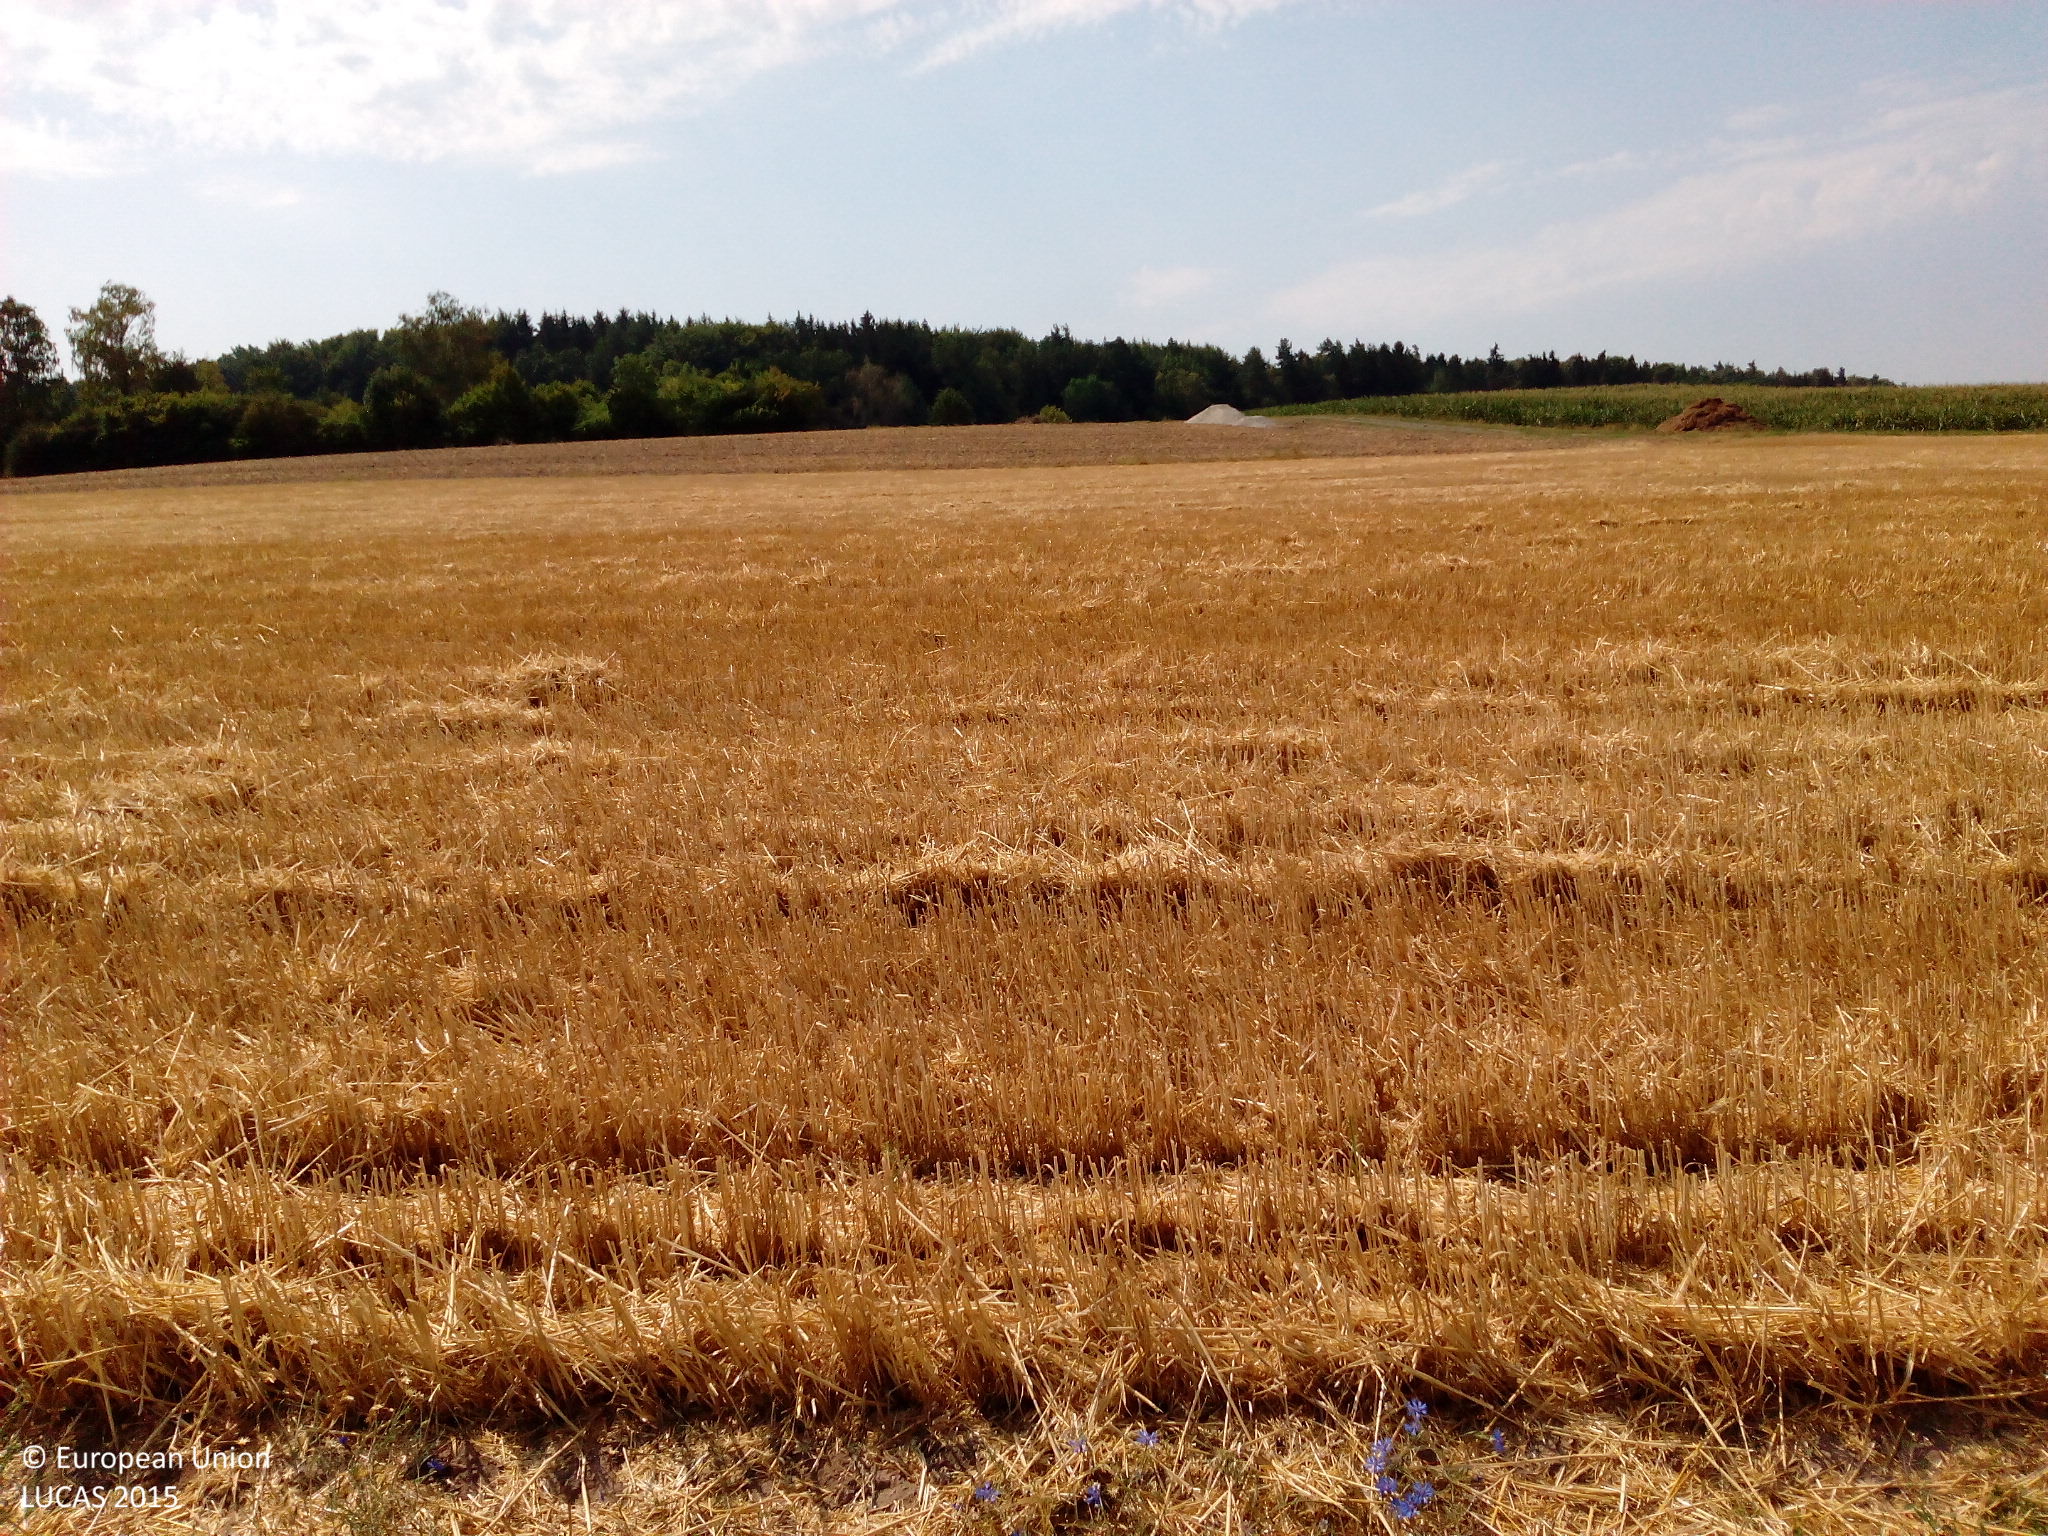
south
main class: Cropland
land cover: Barley
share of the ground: < 10 %
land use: Agriculture (excluding fallow land and kitchen gardens)
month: August
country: DE
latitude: 49.1048
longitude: 10.2601
